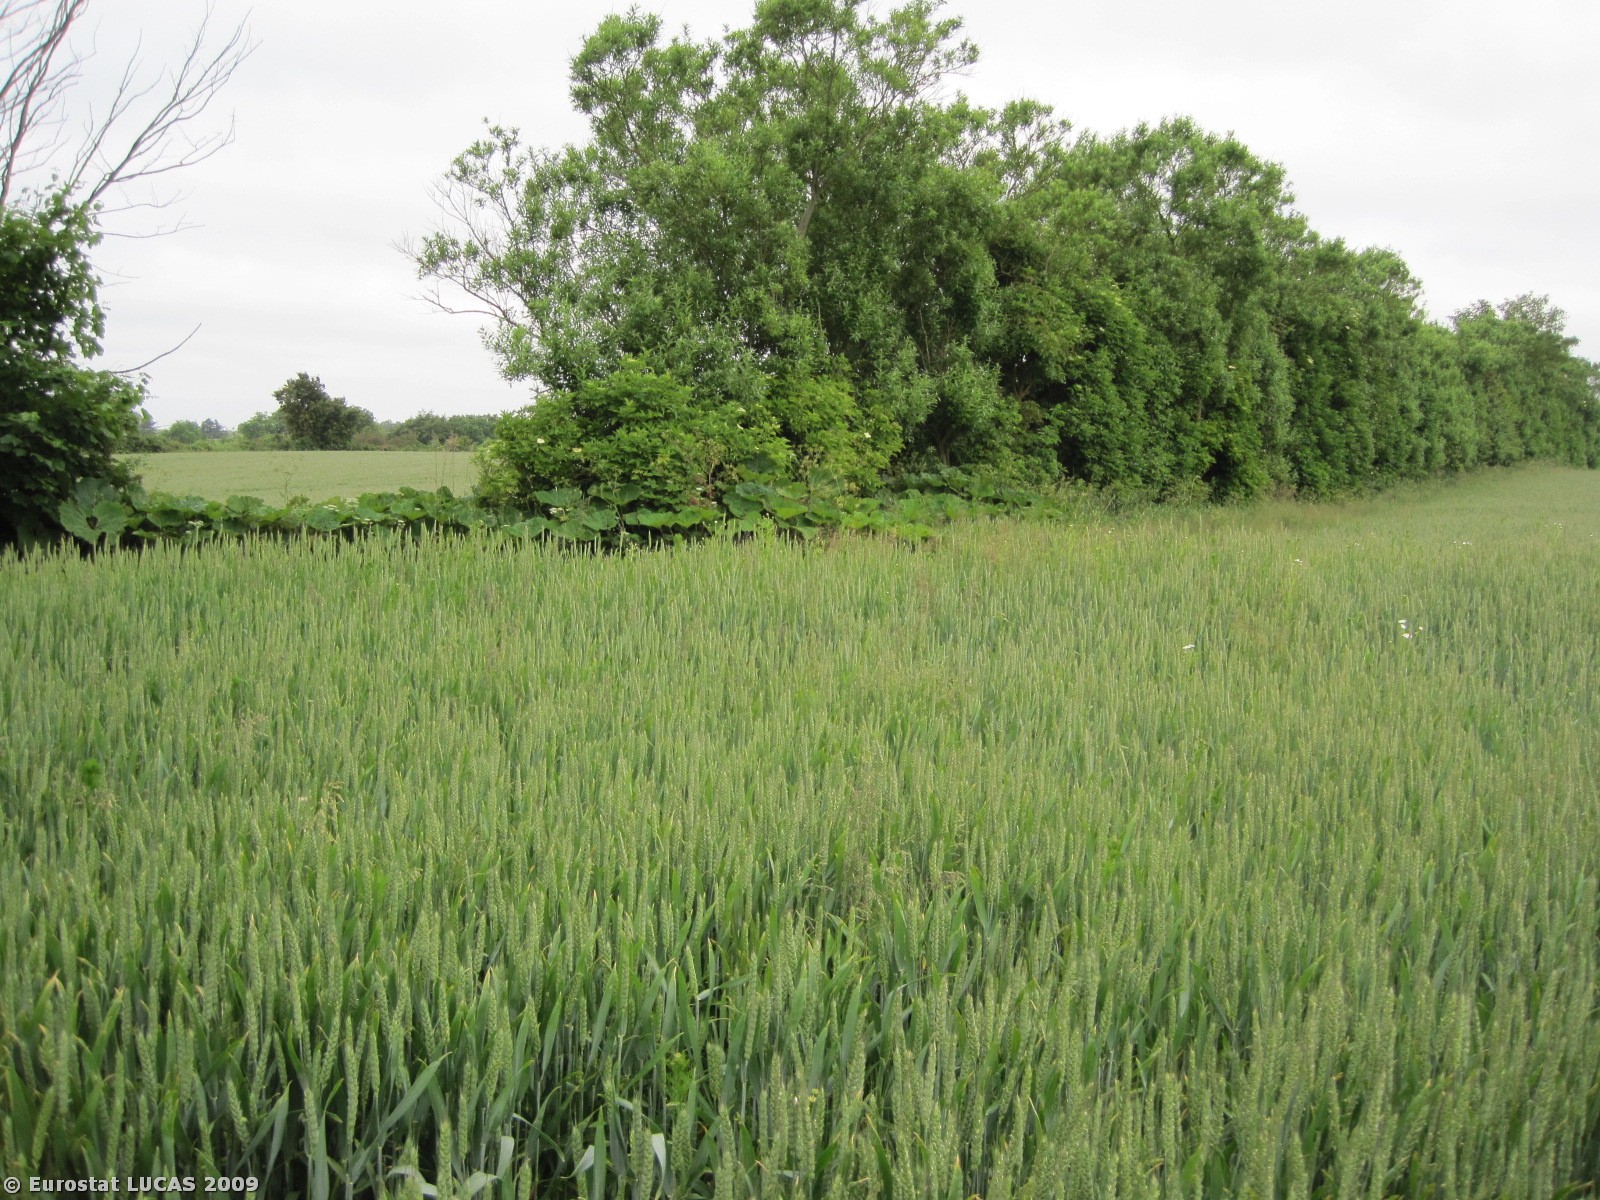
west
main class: Cropland
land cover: Common wheat
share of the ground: > 75 %
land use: Agriculture (excluding fallow land and kitchen gardens)
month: June
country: DK
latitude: 56.7392
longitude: 8.7755
